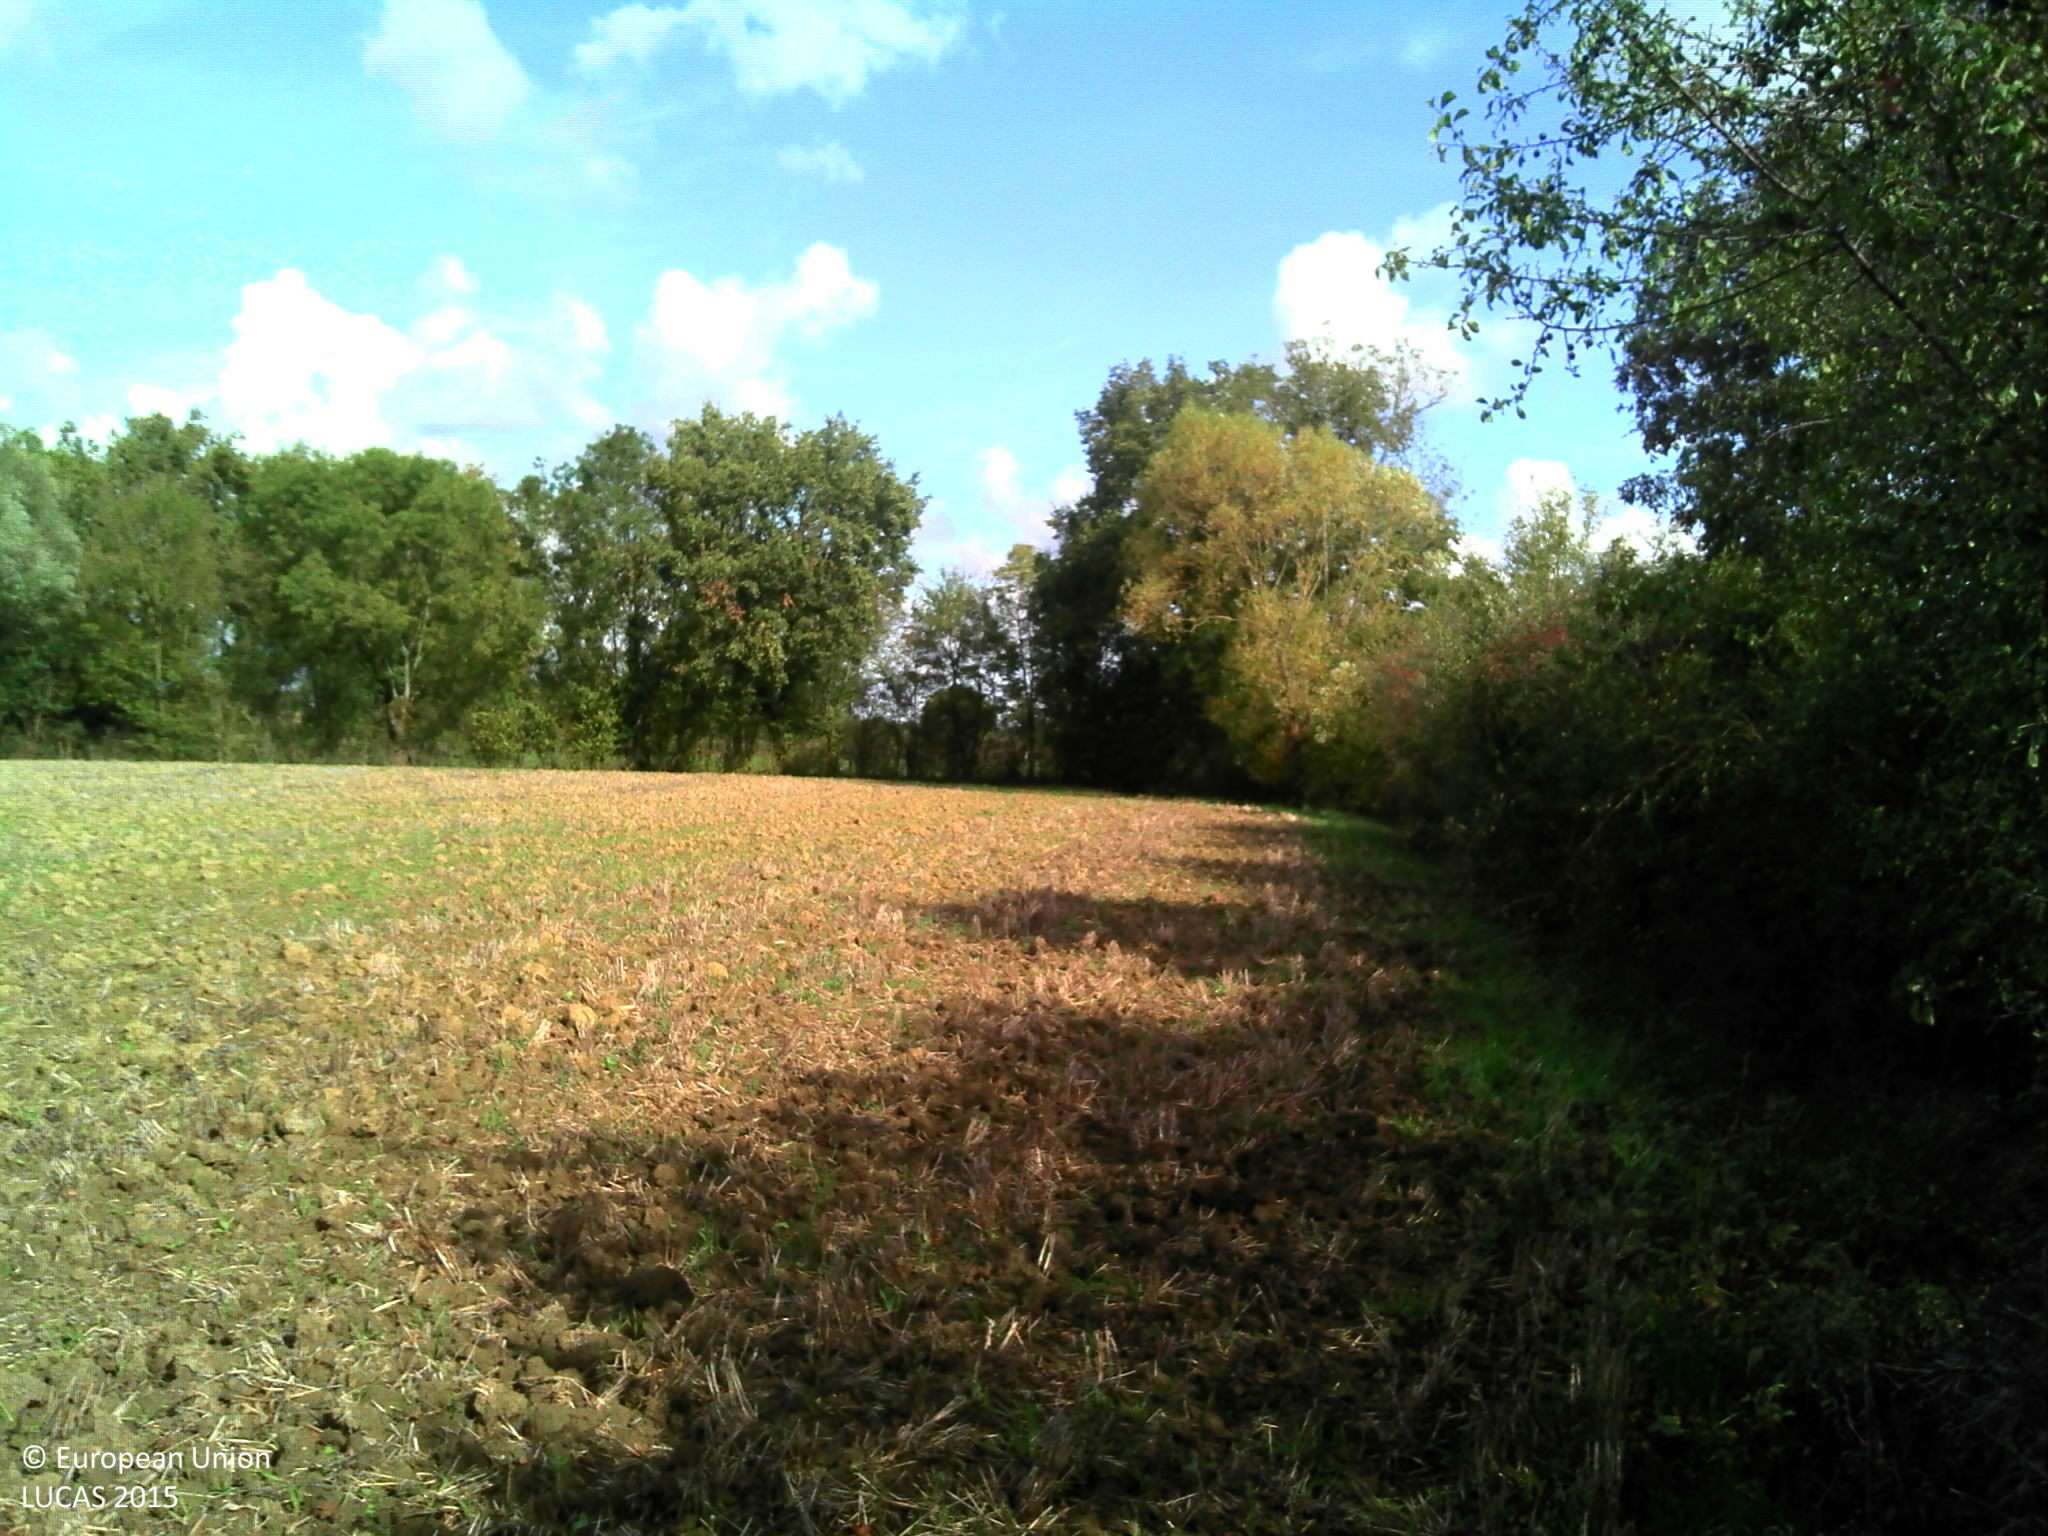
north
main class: Grassland
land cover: Grassland without tree/shrub cover
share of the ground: > 75 %
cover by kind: herbaceous plants 100 %
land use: Agriculture (excluding fallow land and kitchen gardens)
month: October
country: FR
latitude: 46.3665
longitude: 5.1281
